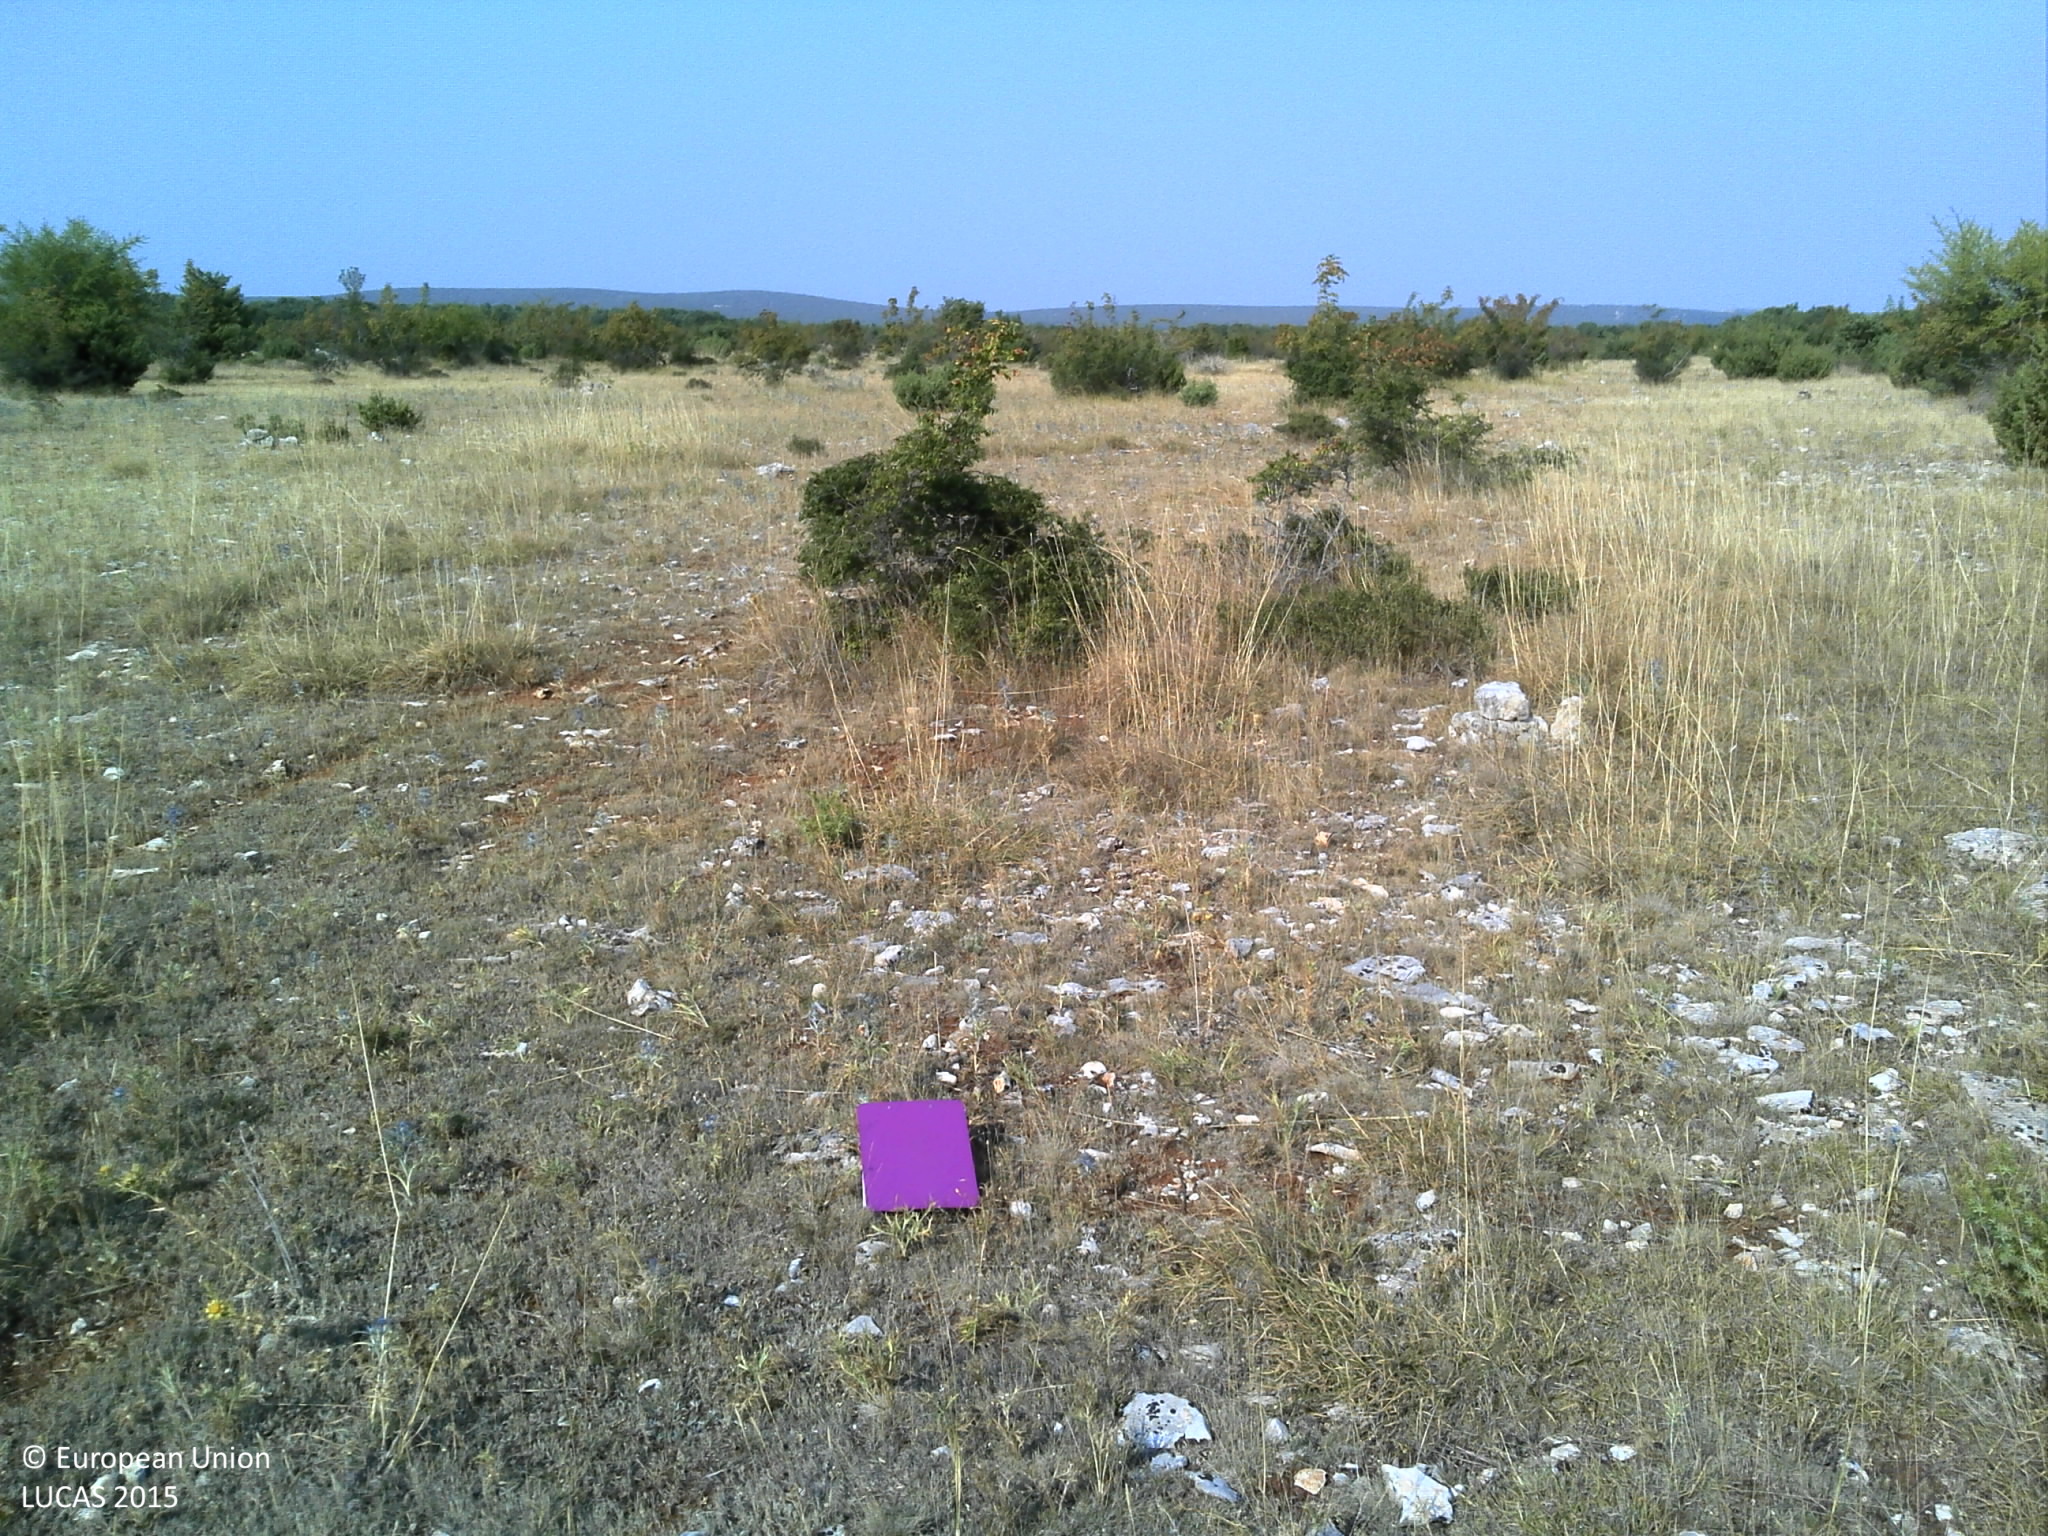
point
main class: Grassland
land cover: Grassland with sparse tree/shrub cover
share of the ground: > 75 %
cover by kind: herbaceous plants 65 %, unconsolidated bare surface 20 %, shrubs 10 %, broadleaved forest trees 5 %
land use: Semi-natural and natural areas not in use
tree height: < 5 m
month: August
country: HR
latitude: 44.0189
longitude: 15.9177
